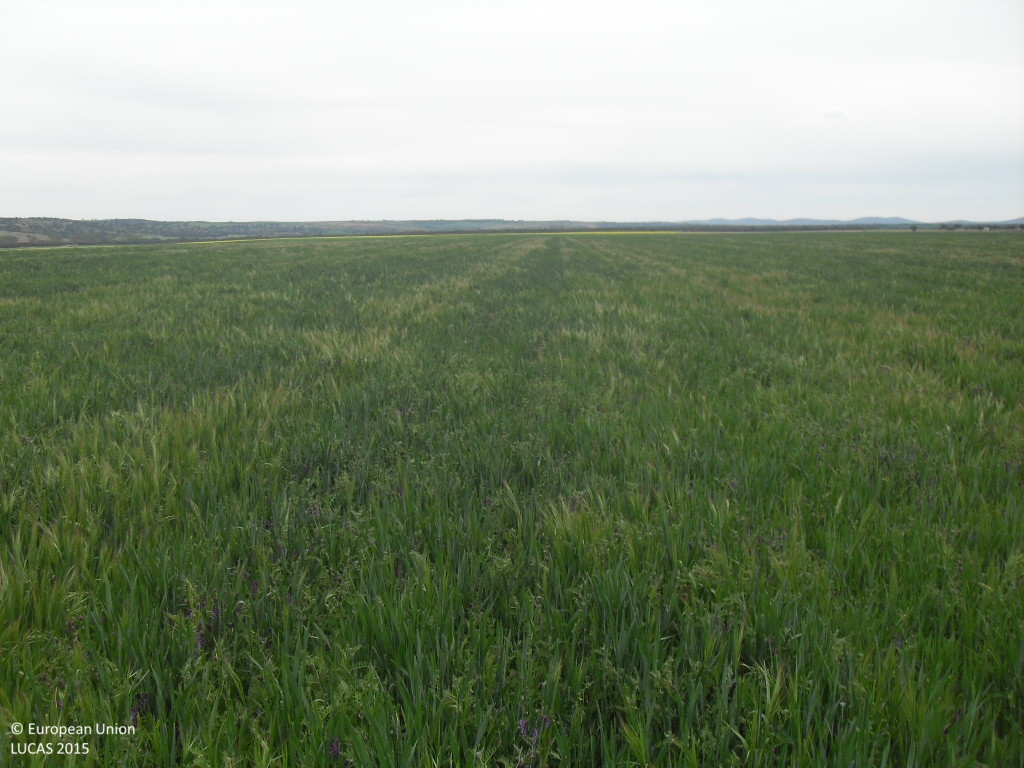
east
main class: Cropland
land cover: Mixed cereals for fodder
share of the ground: > 75 %
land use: Agriculture (excluding fallow land and kitchen gardens)
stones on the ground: 10 - 25 %
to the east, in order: Mixed cereals for fodder
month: April
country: ES
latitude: 40.8403
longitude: -5.1879
